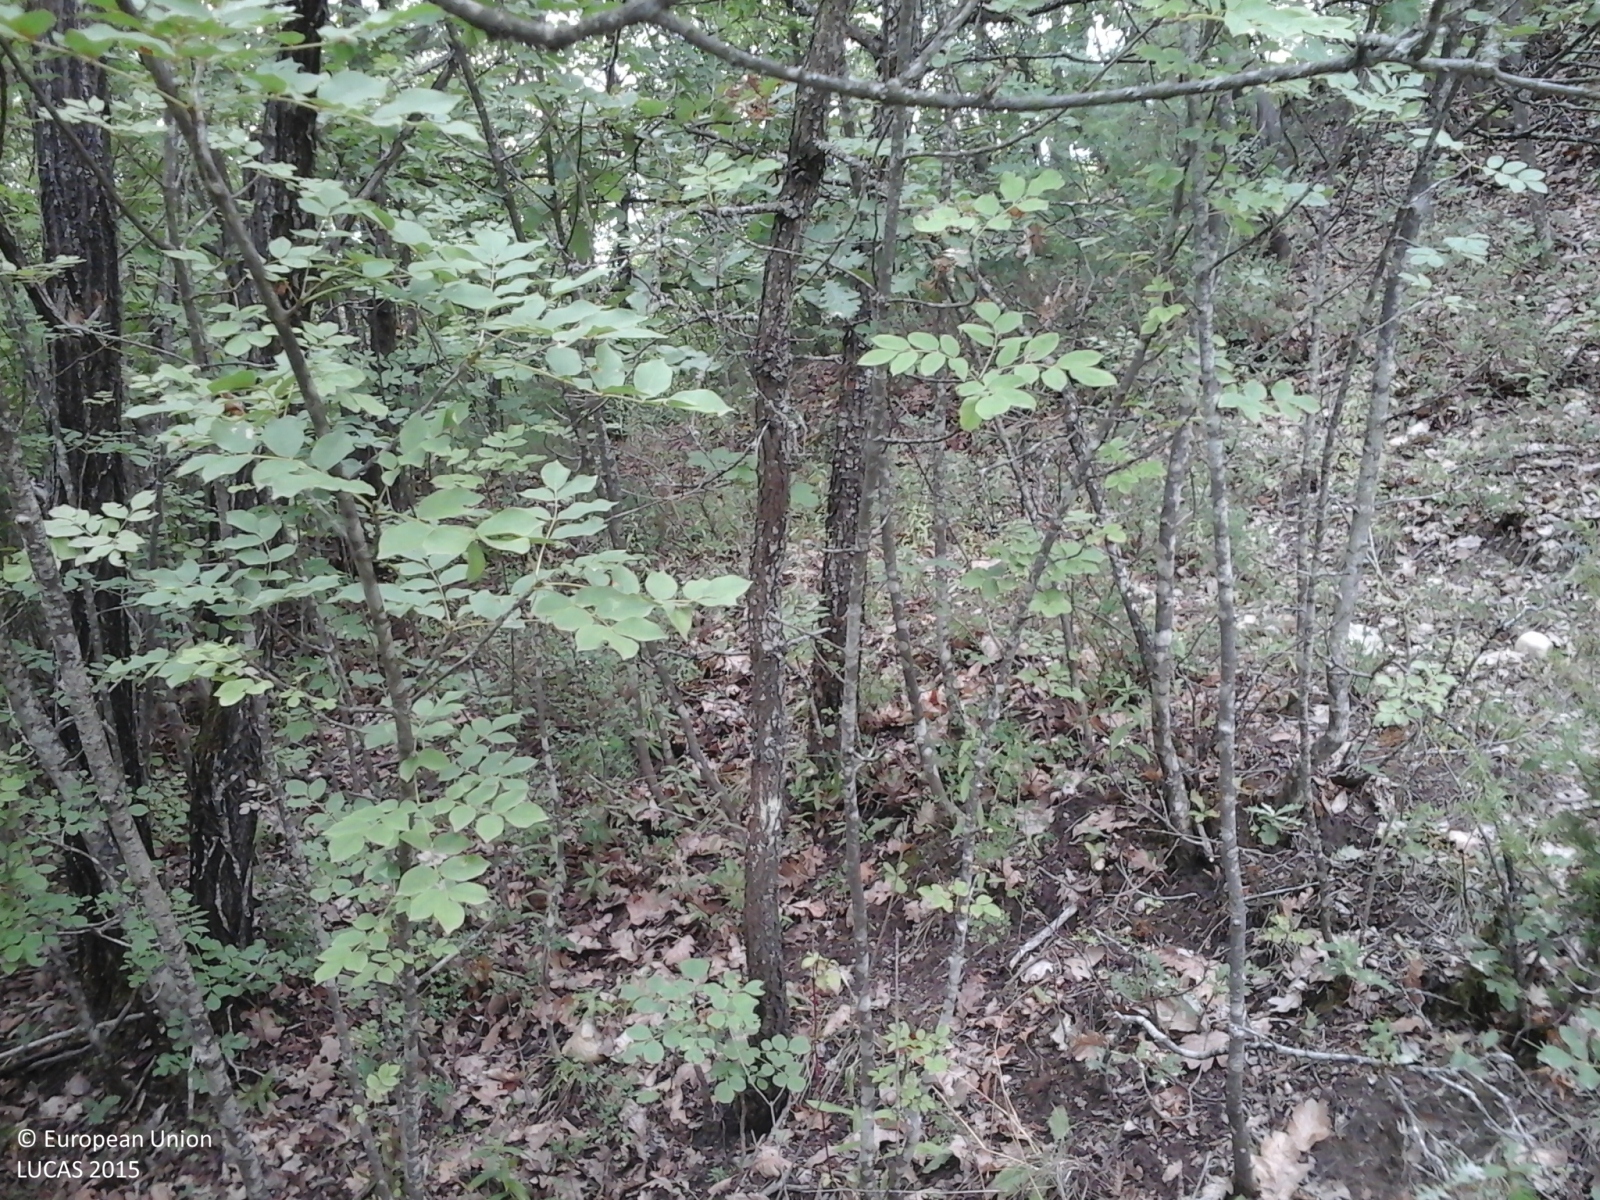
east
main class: Woodland
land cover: Broadleaved woodland
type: thermophilous deciduous forest
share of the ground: > 75 %
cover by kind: broadleaved forest trees 95 %, unconsolidated bare surface 5 %
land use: Forestry
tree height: < 5 m
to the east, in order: Broadleaved woodland
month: August
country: IT
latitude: 44.8162
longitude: 9.1797
